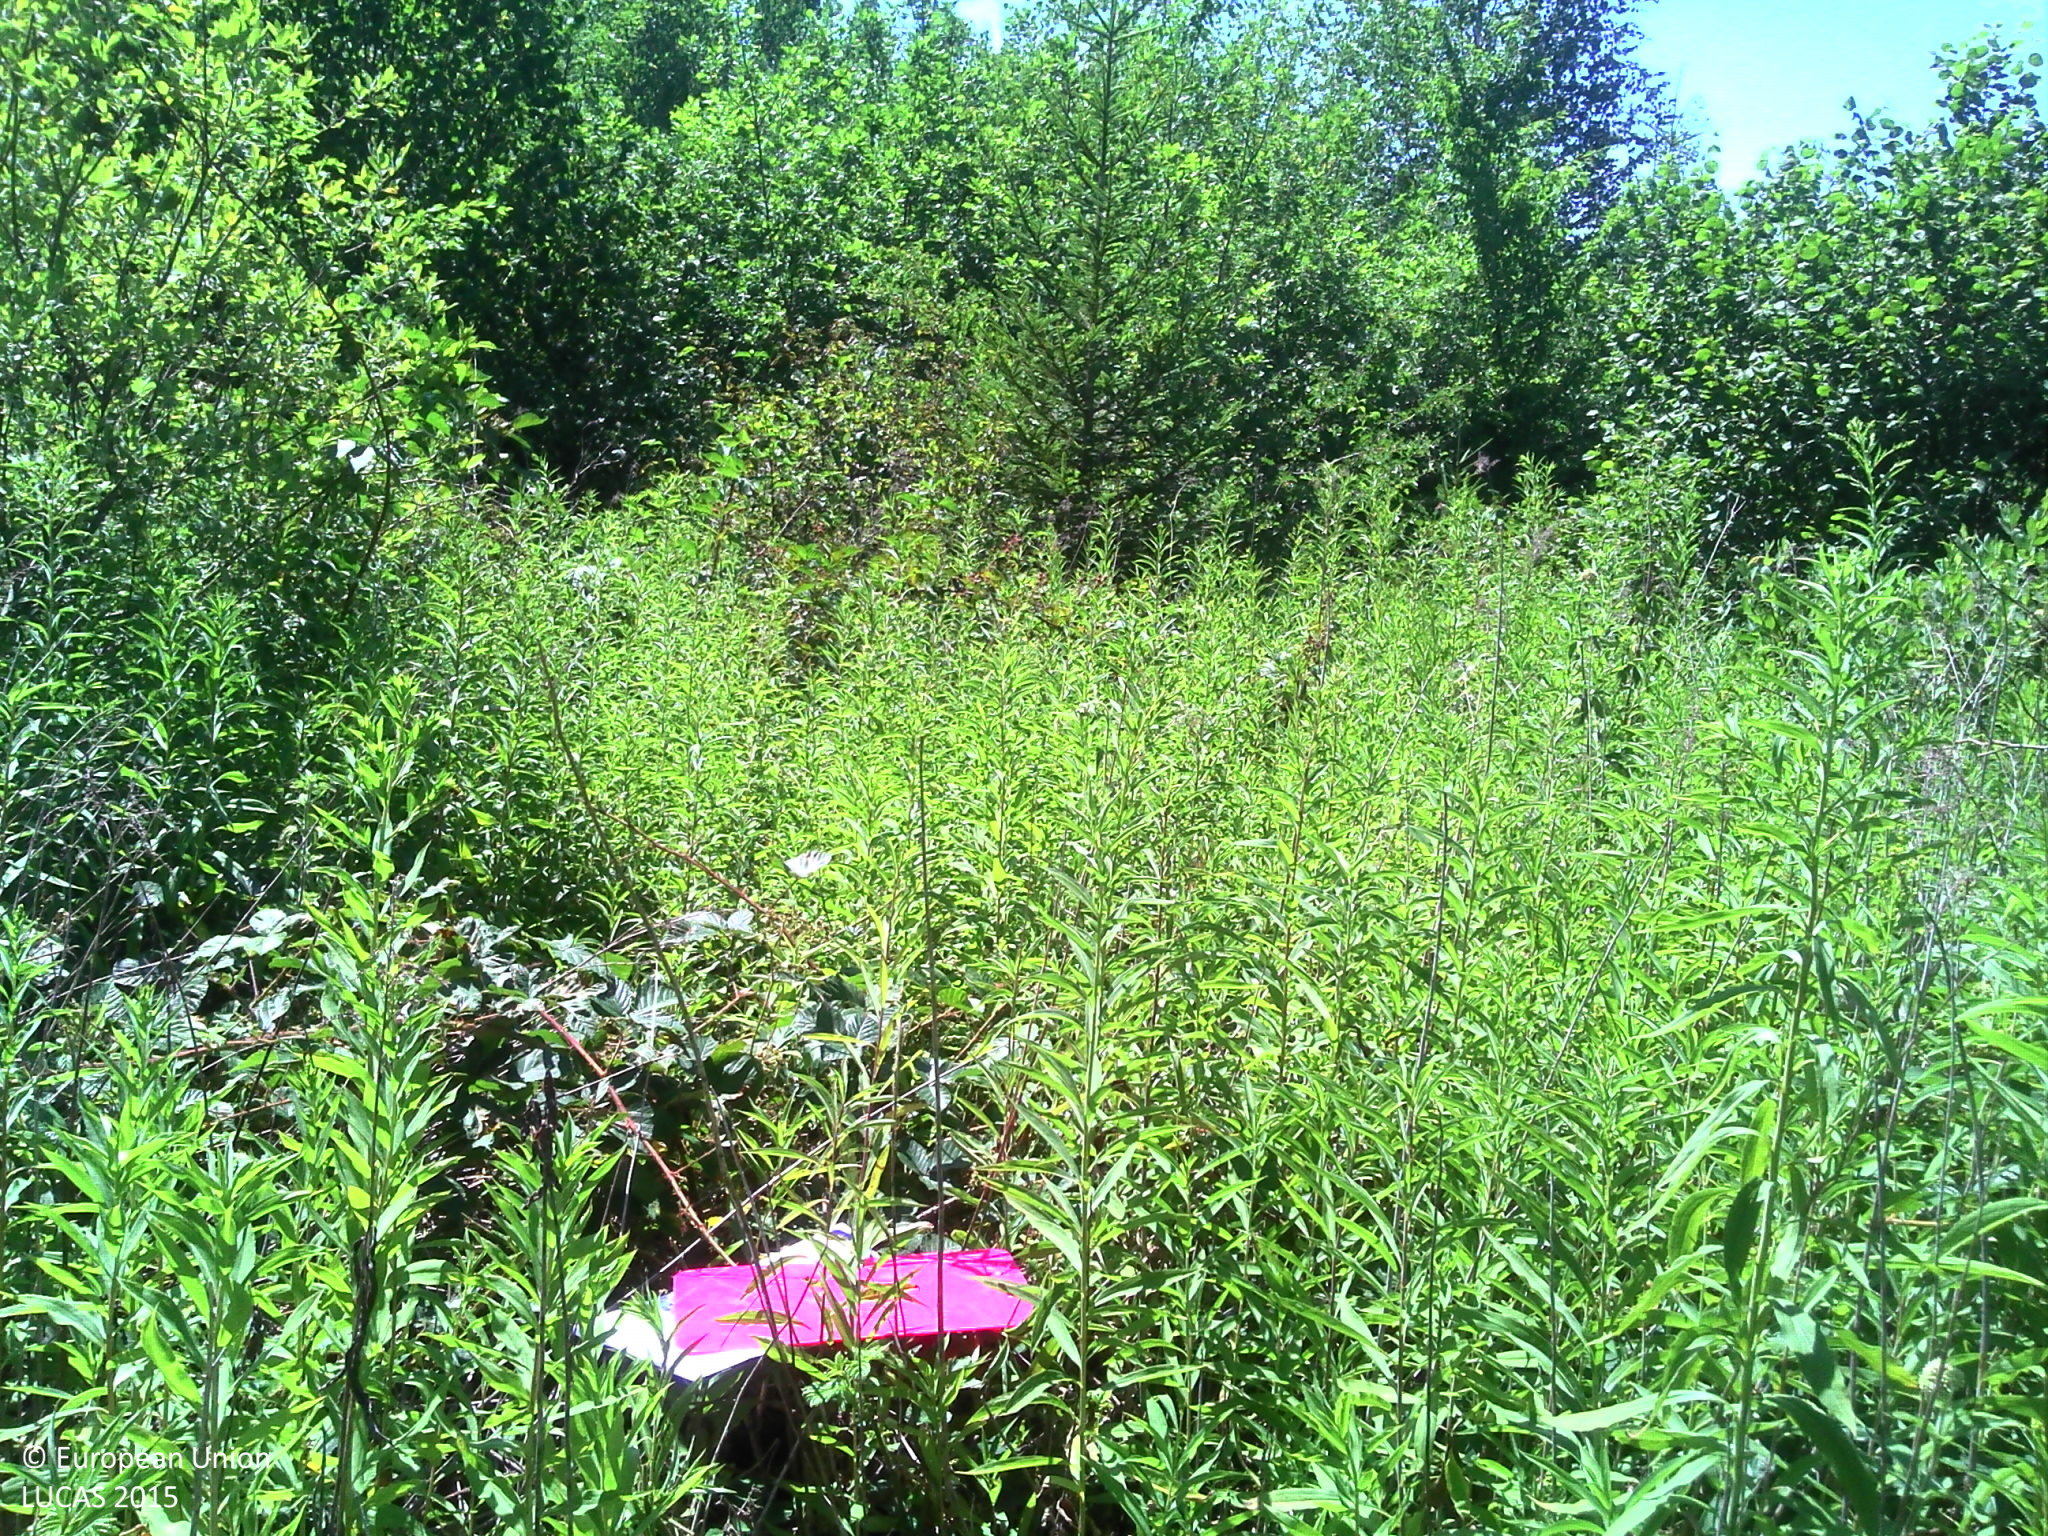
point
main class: Shrubland
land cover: Shrubland with sparse tree cover
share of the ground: > 75 %
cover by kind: shrubs 60 %, herbaceous plants 35 %, broadleaved forest trees 5 %
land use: Abandoned areas
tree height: < 5 m
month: July
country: FR
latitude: 46.3089
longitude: 6.4065
